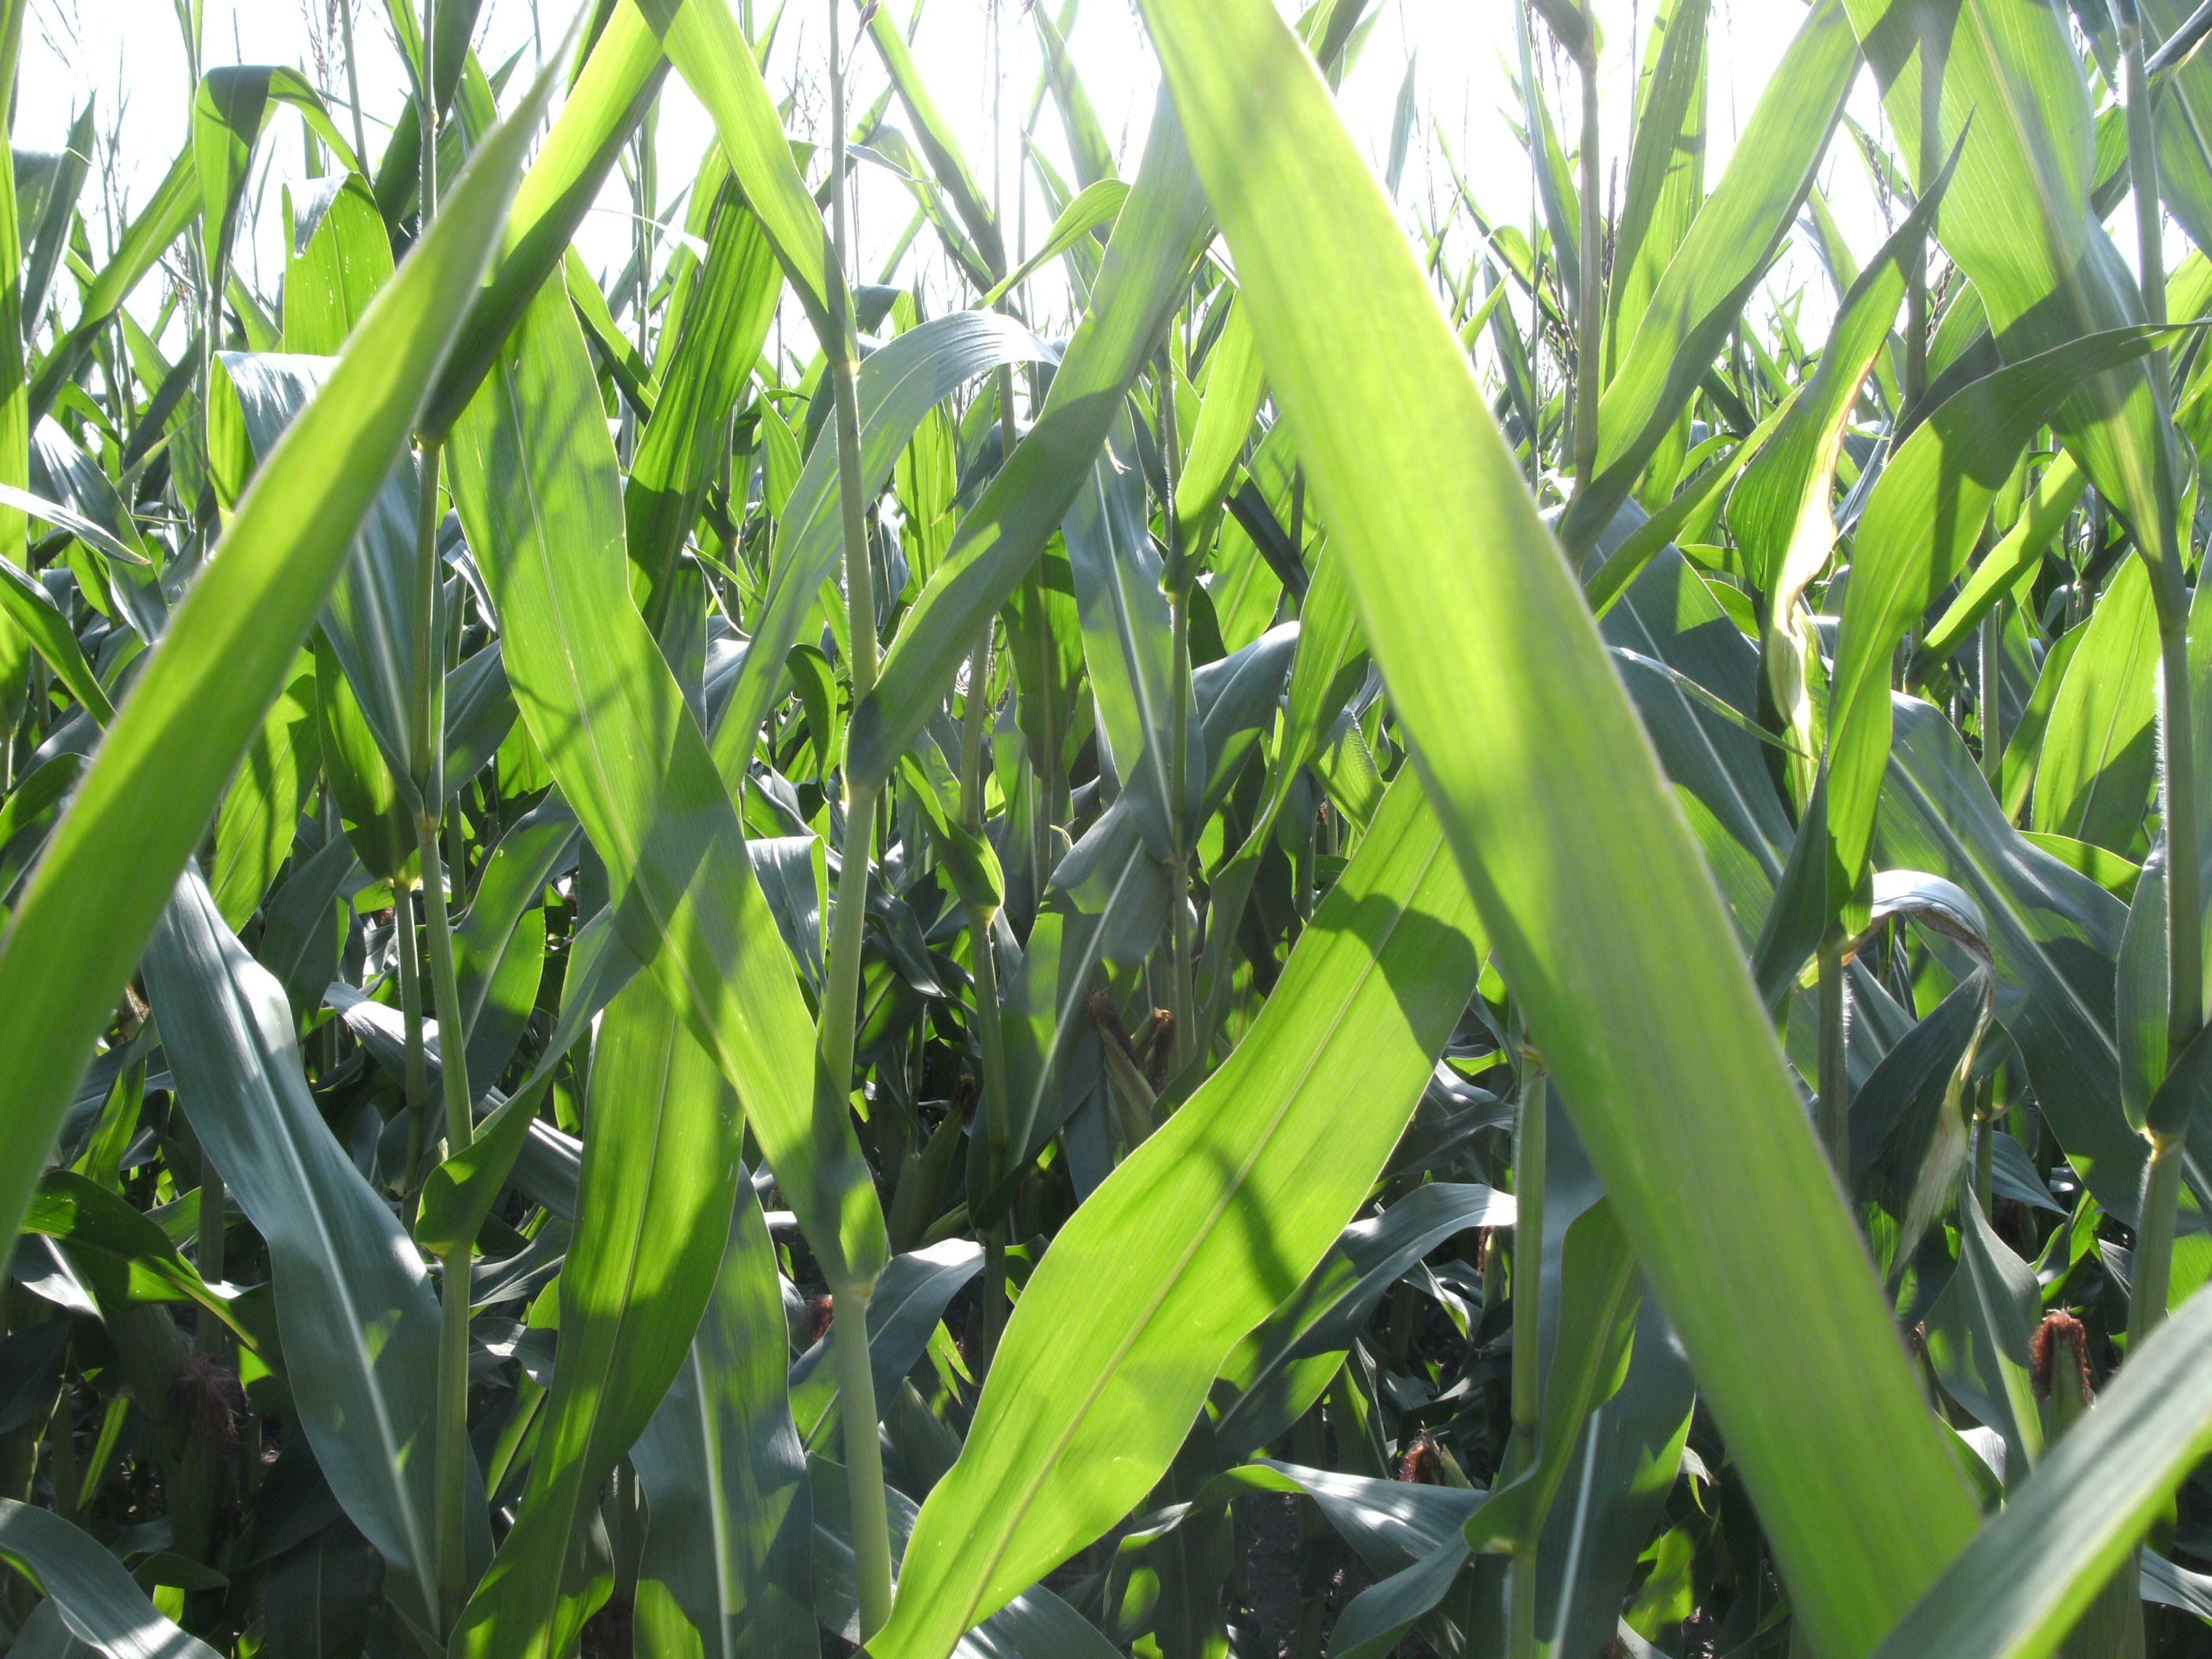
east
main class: Grassland
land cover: Grassland without tree/shrub cover
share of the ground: > 75 %
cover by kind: herbaceous plants 100 %
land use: Agriculture (excluding fallow land and kitchen gardens)
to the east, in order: Grassland without tree/shrub cover; Maize
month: July
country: AT
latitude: 48.2576
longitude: 13.5149
